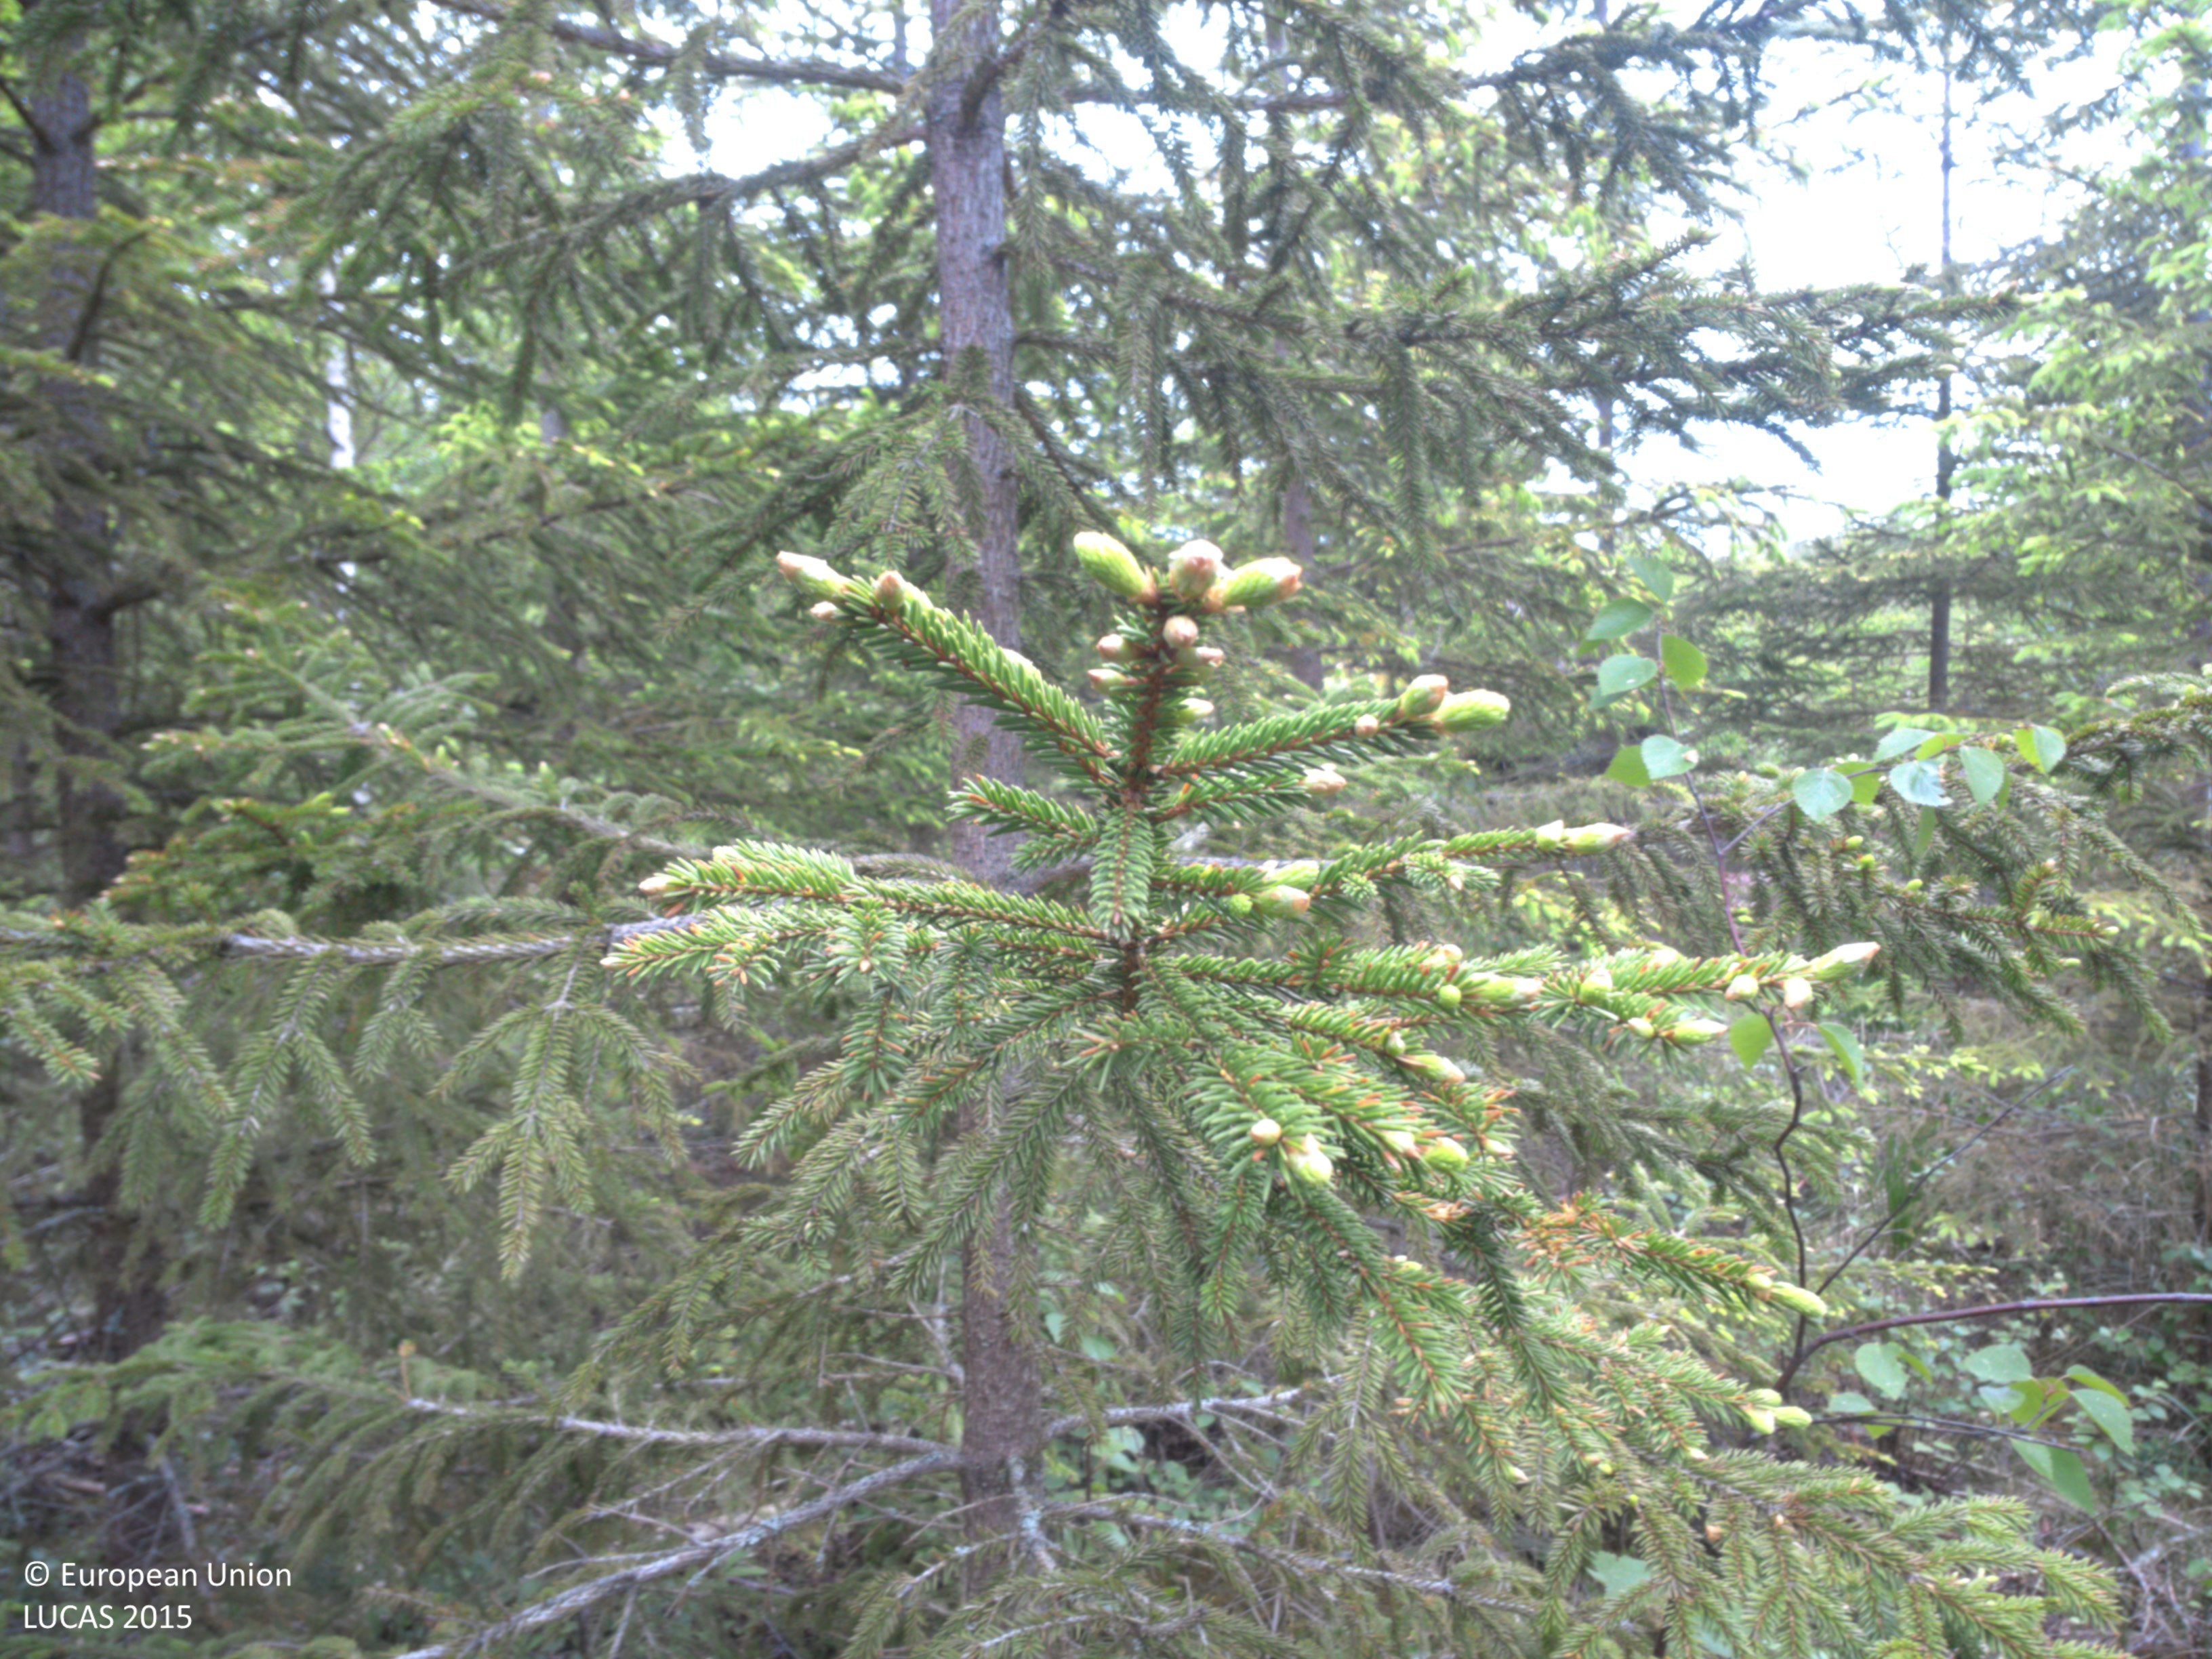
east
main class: Woodland
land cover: Spruce dominated mixed woodland
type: boreal forest
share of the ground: 50 - 75 %
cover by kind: coniferous forest trees 45 %, broadleaved forest trees 25 %, herbaceous plants 20 %, shrubs 10 %
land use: Forestry
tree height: > 5 m
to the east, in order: Spruce dominated mixed woodland; Spruce dominated coniferous woodland; Ditches and canals; Spruce dominated coniferous woodland
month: June
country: SE
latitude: 59.1587
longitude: 11.9713
